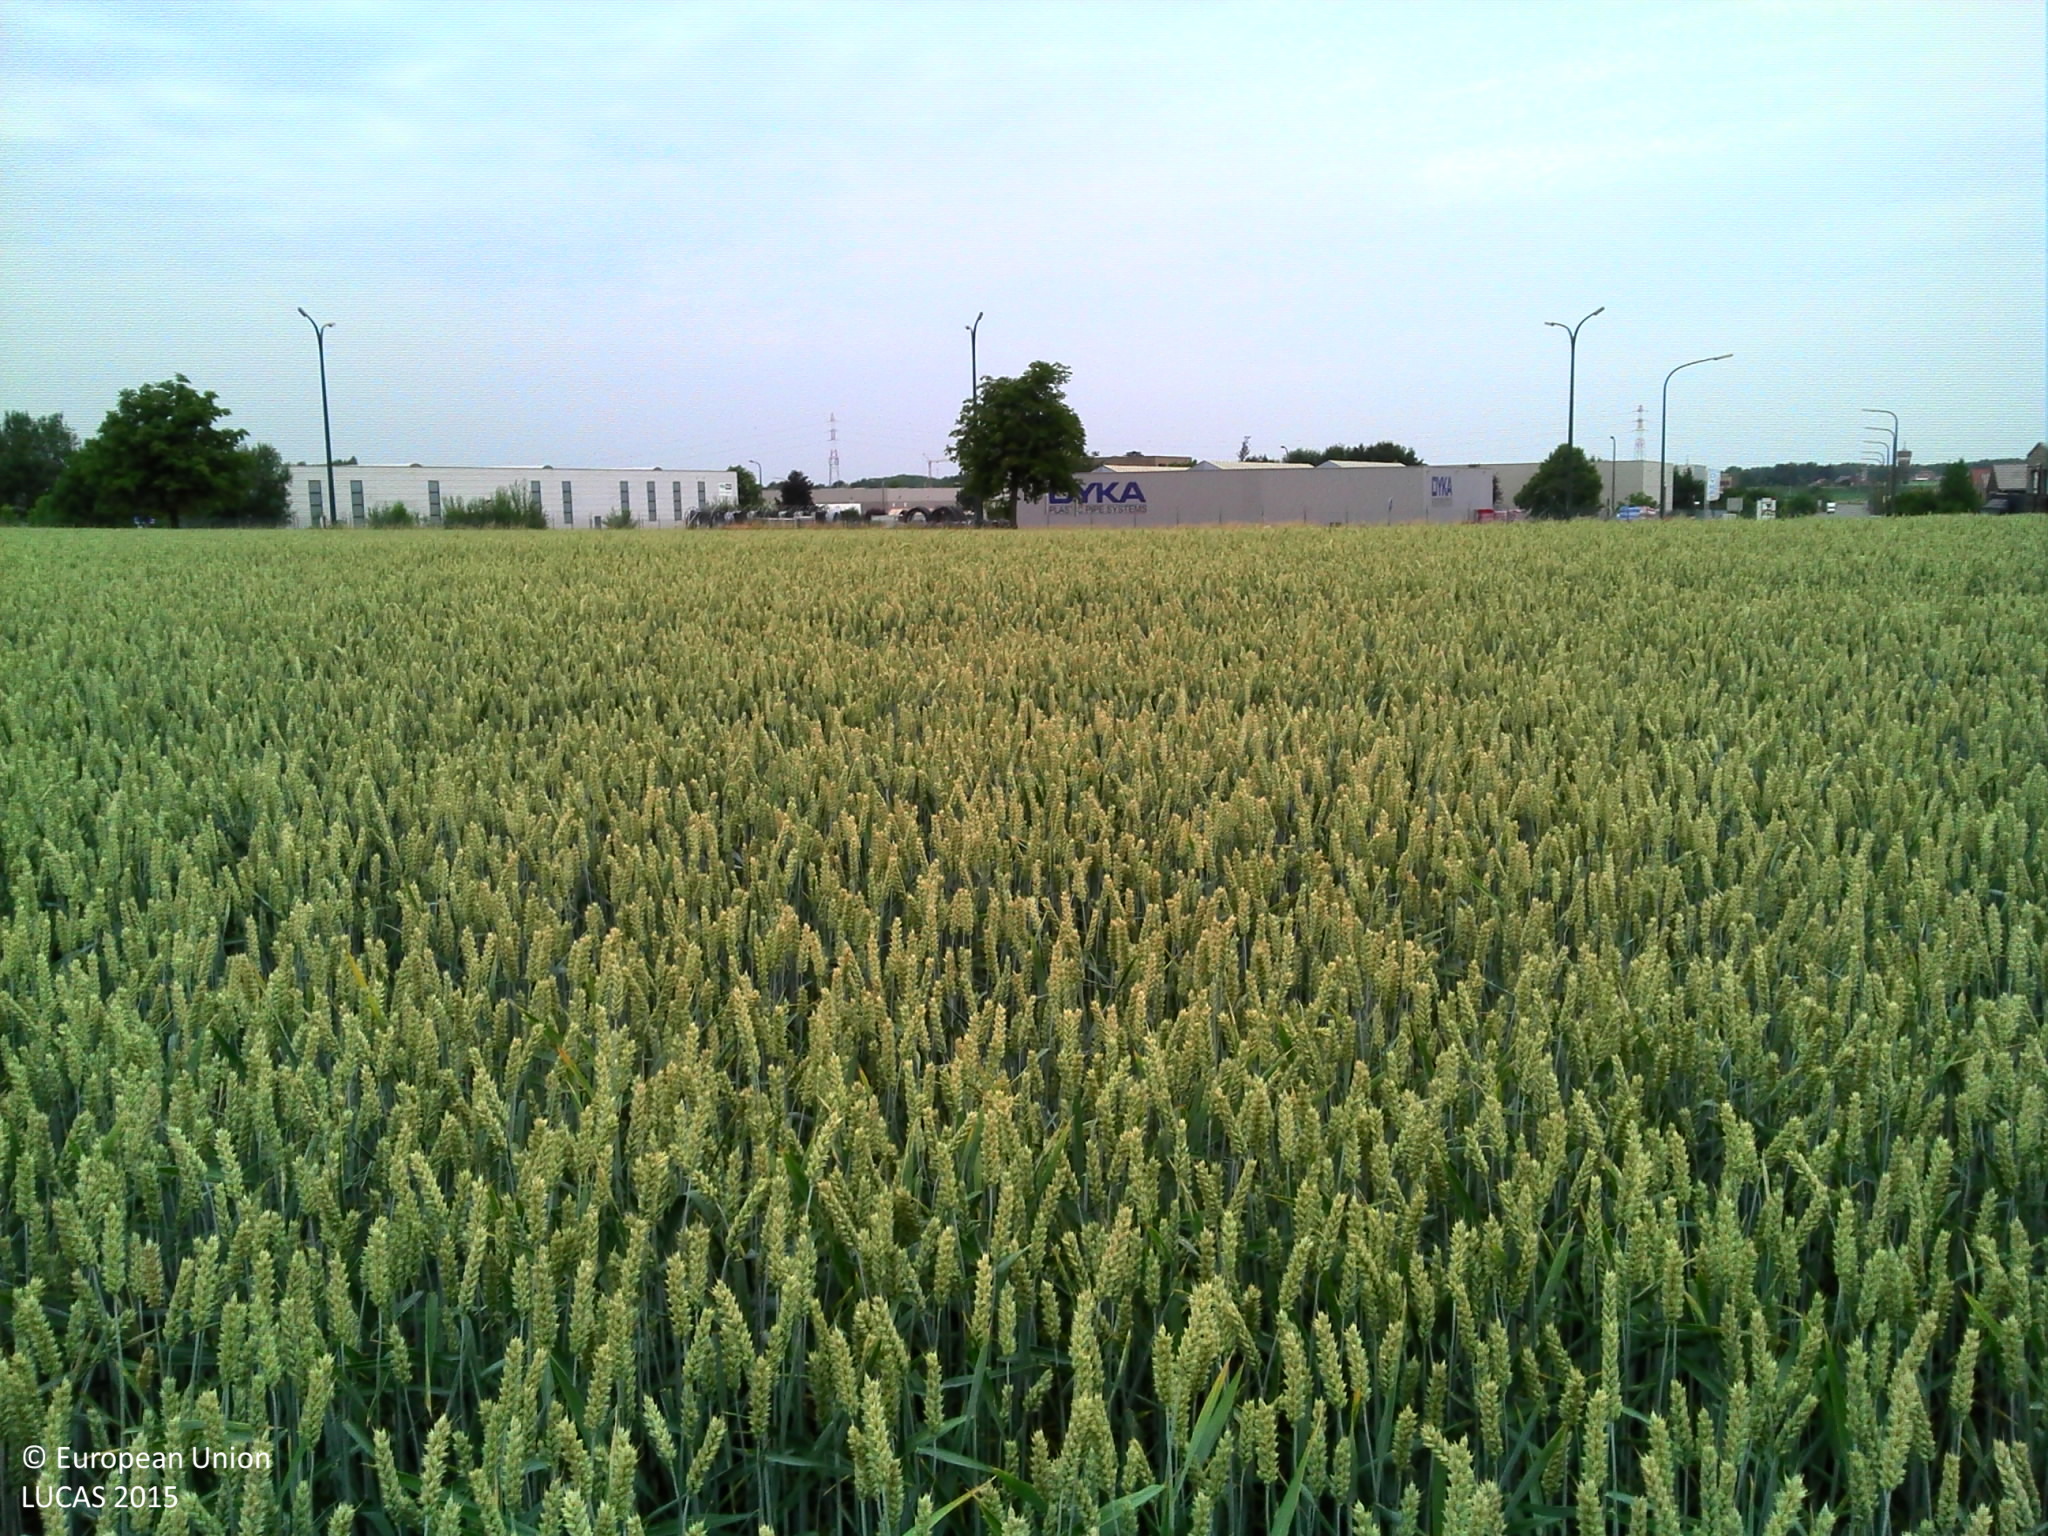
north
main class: Cropland
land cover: Common wheat
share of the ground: > 75 %
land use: Agriculture (excluding fallow land and kitchen gardens)
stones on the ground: < 10 %
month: July
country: BE
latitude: 50.4655
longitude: 4.4874
